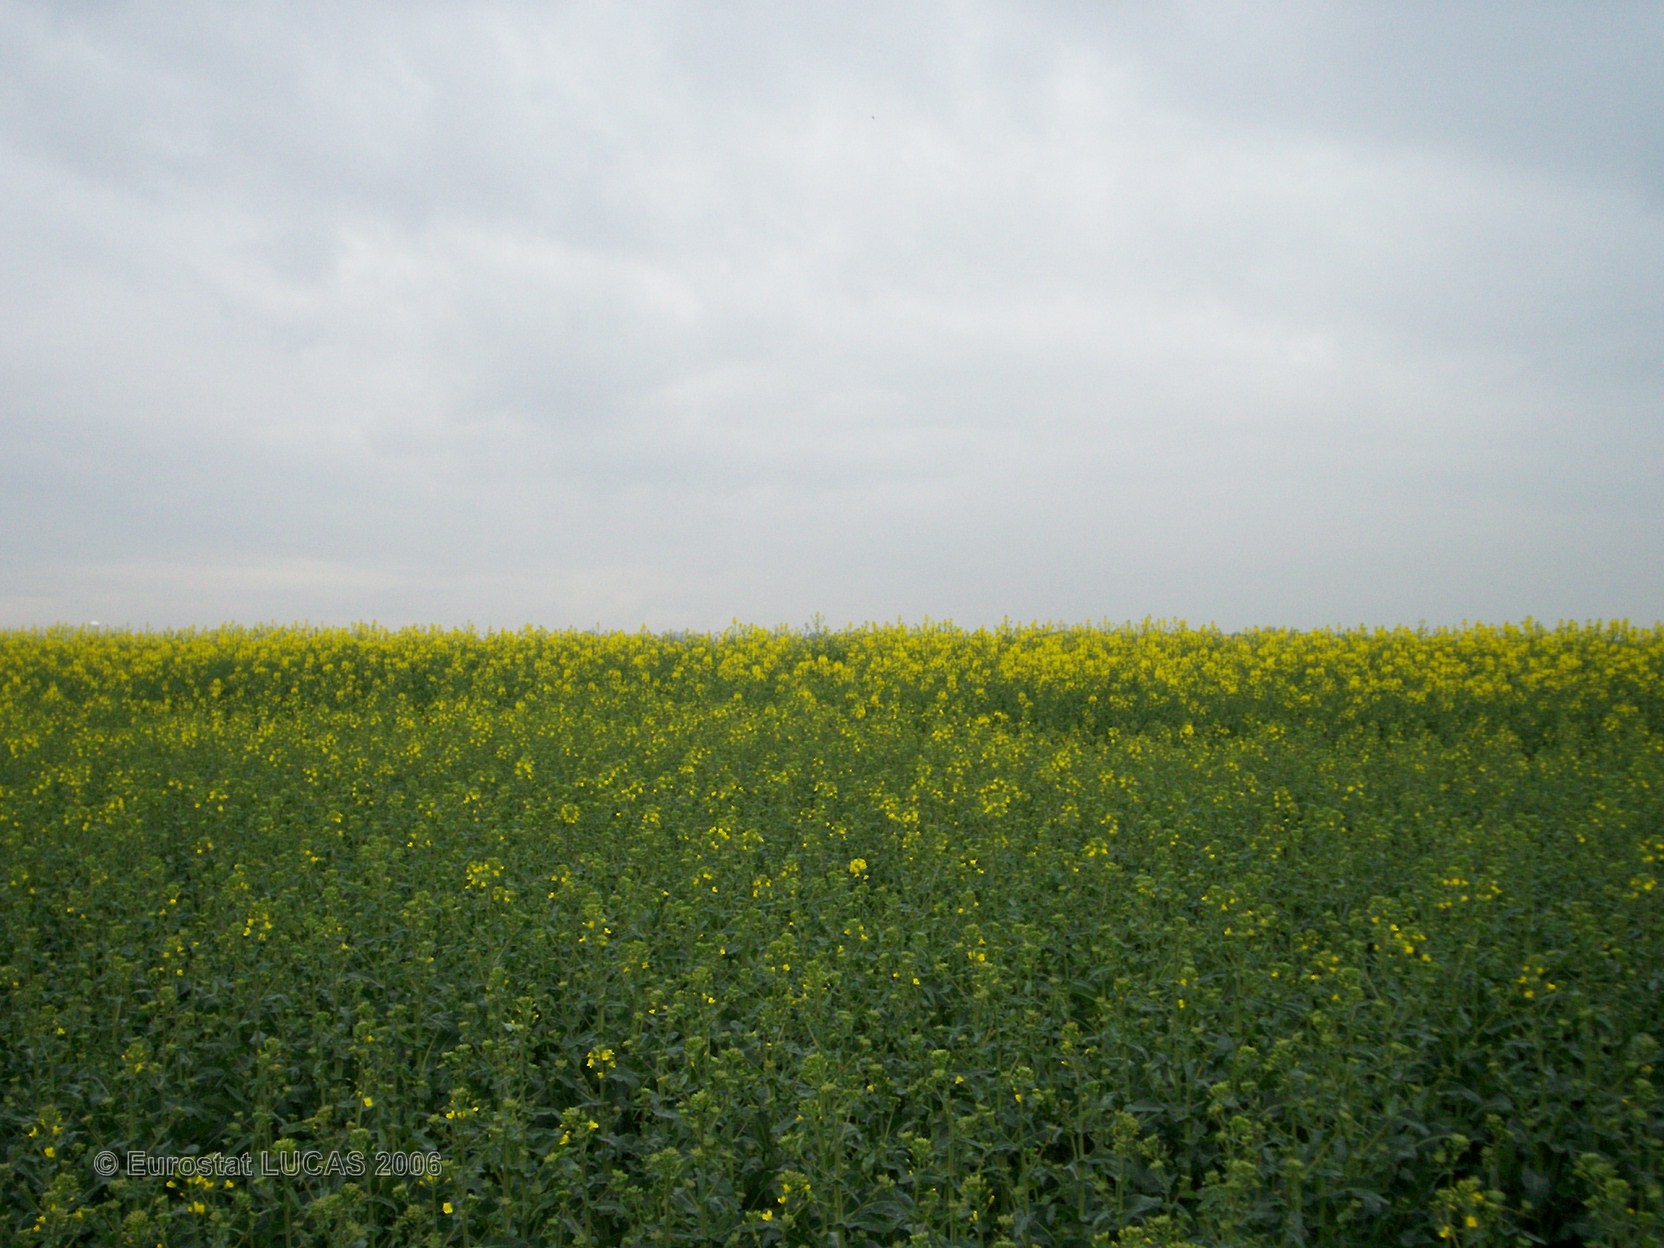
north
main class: Cropland
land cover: Rape and turnip rape
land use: Agriculture (excluding fallow land and kitchen gardens)
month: April
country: FR
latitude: 48.2222
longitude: 2.7901
